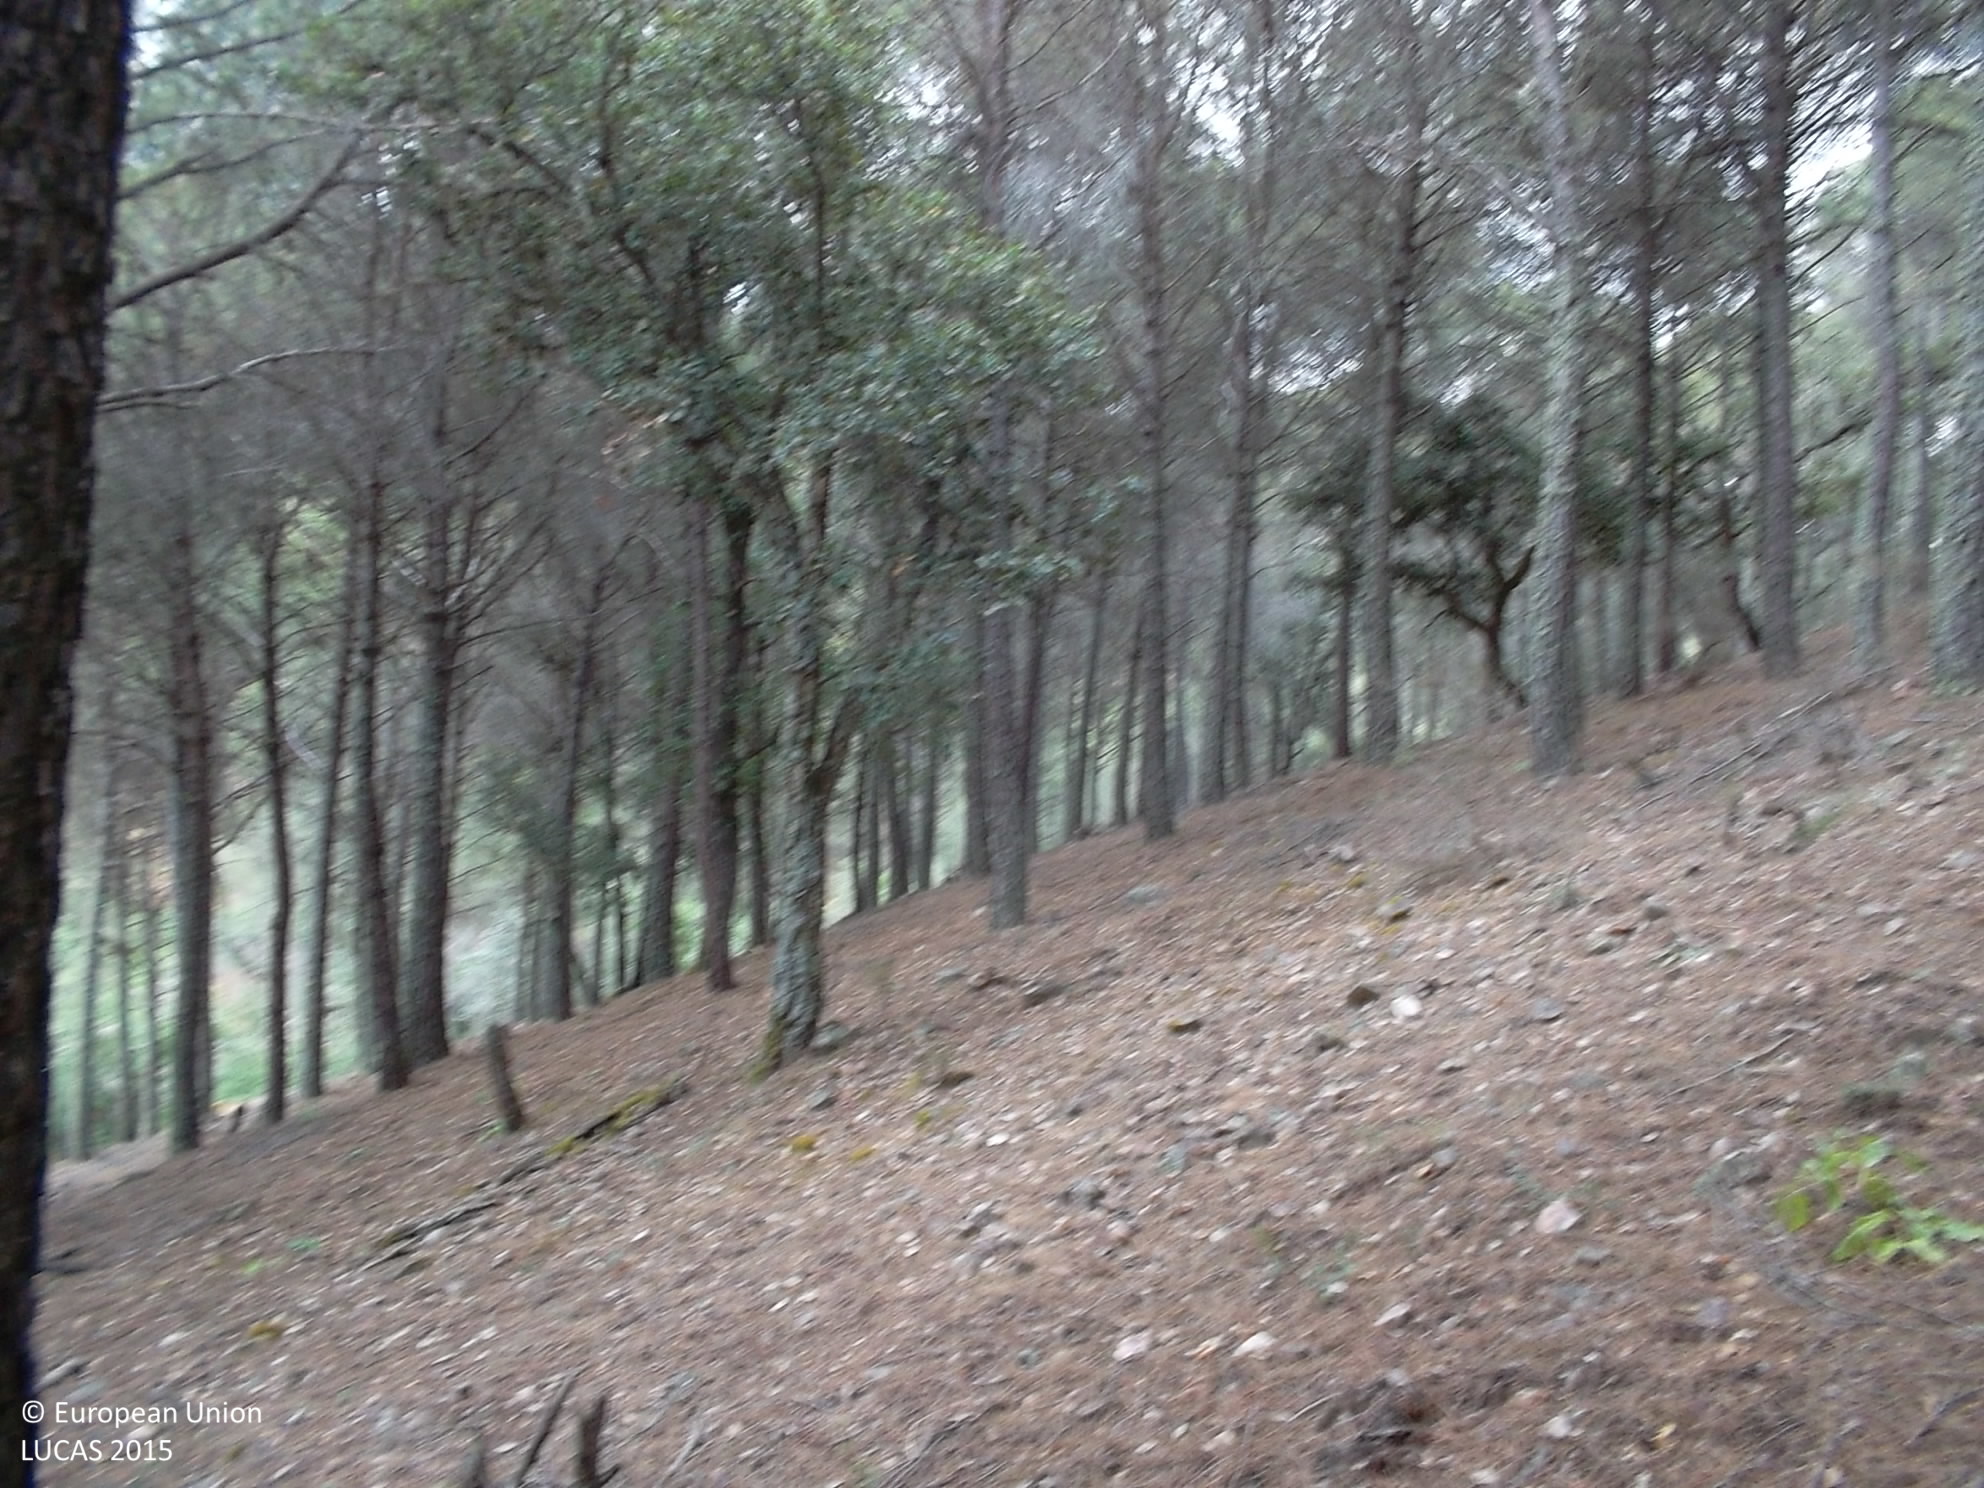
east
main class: Woodland
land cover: Pine dominated coniferous woodland
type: alpine coniferous forest
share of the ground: > 75 %
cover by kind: coniferous forest trees 100 %
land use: Forestry
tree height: > 5 m
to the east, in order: Pine dominated coniferous woodland; Broadleaved woodland; Rivers and streams; Pine dominated coniferous woodland; Spontaneously vegetated surfaces; Electric lines; Spontaneously vegetated surfaces; Pine dominated coniferous woodland
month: June
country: ES
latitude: 39.0008
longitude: -4.4964
